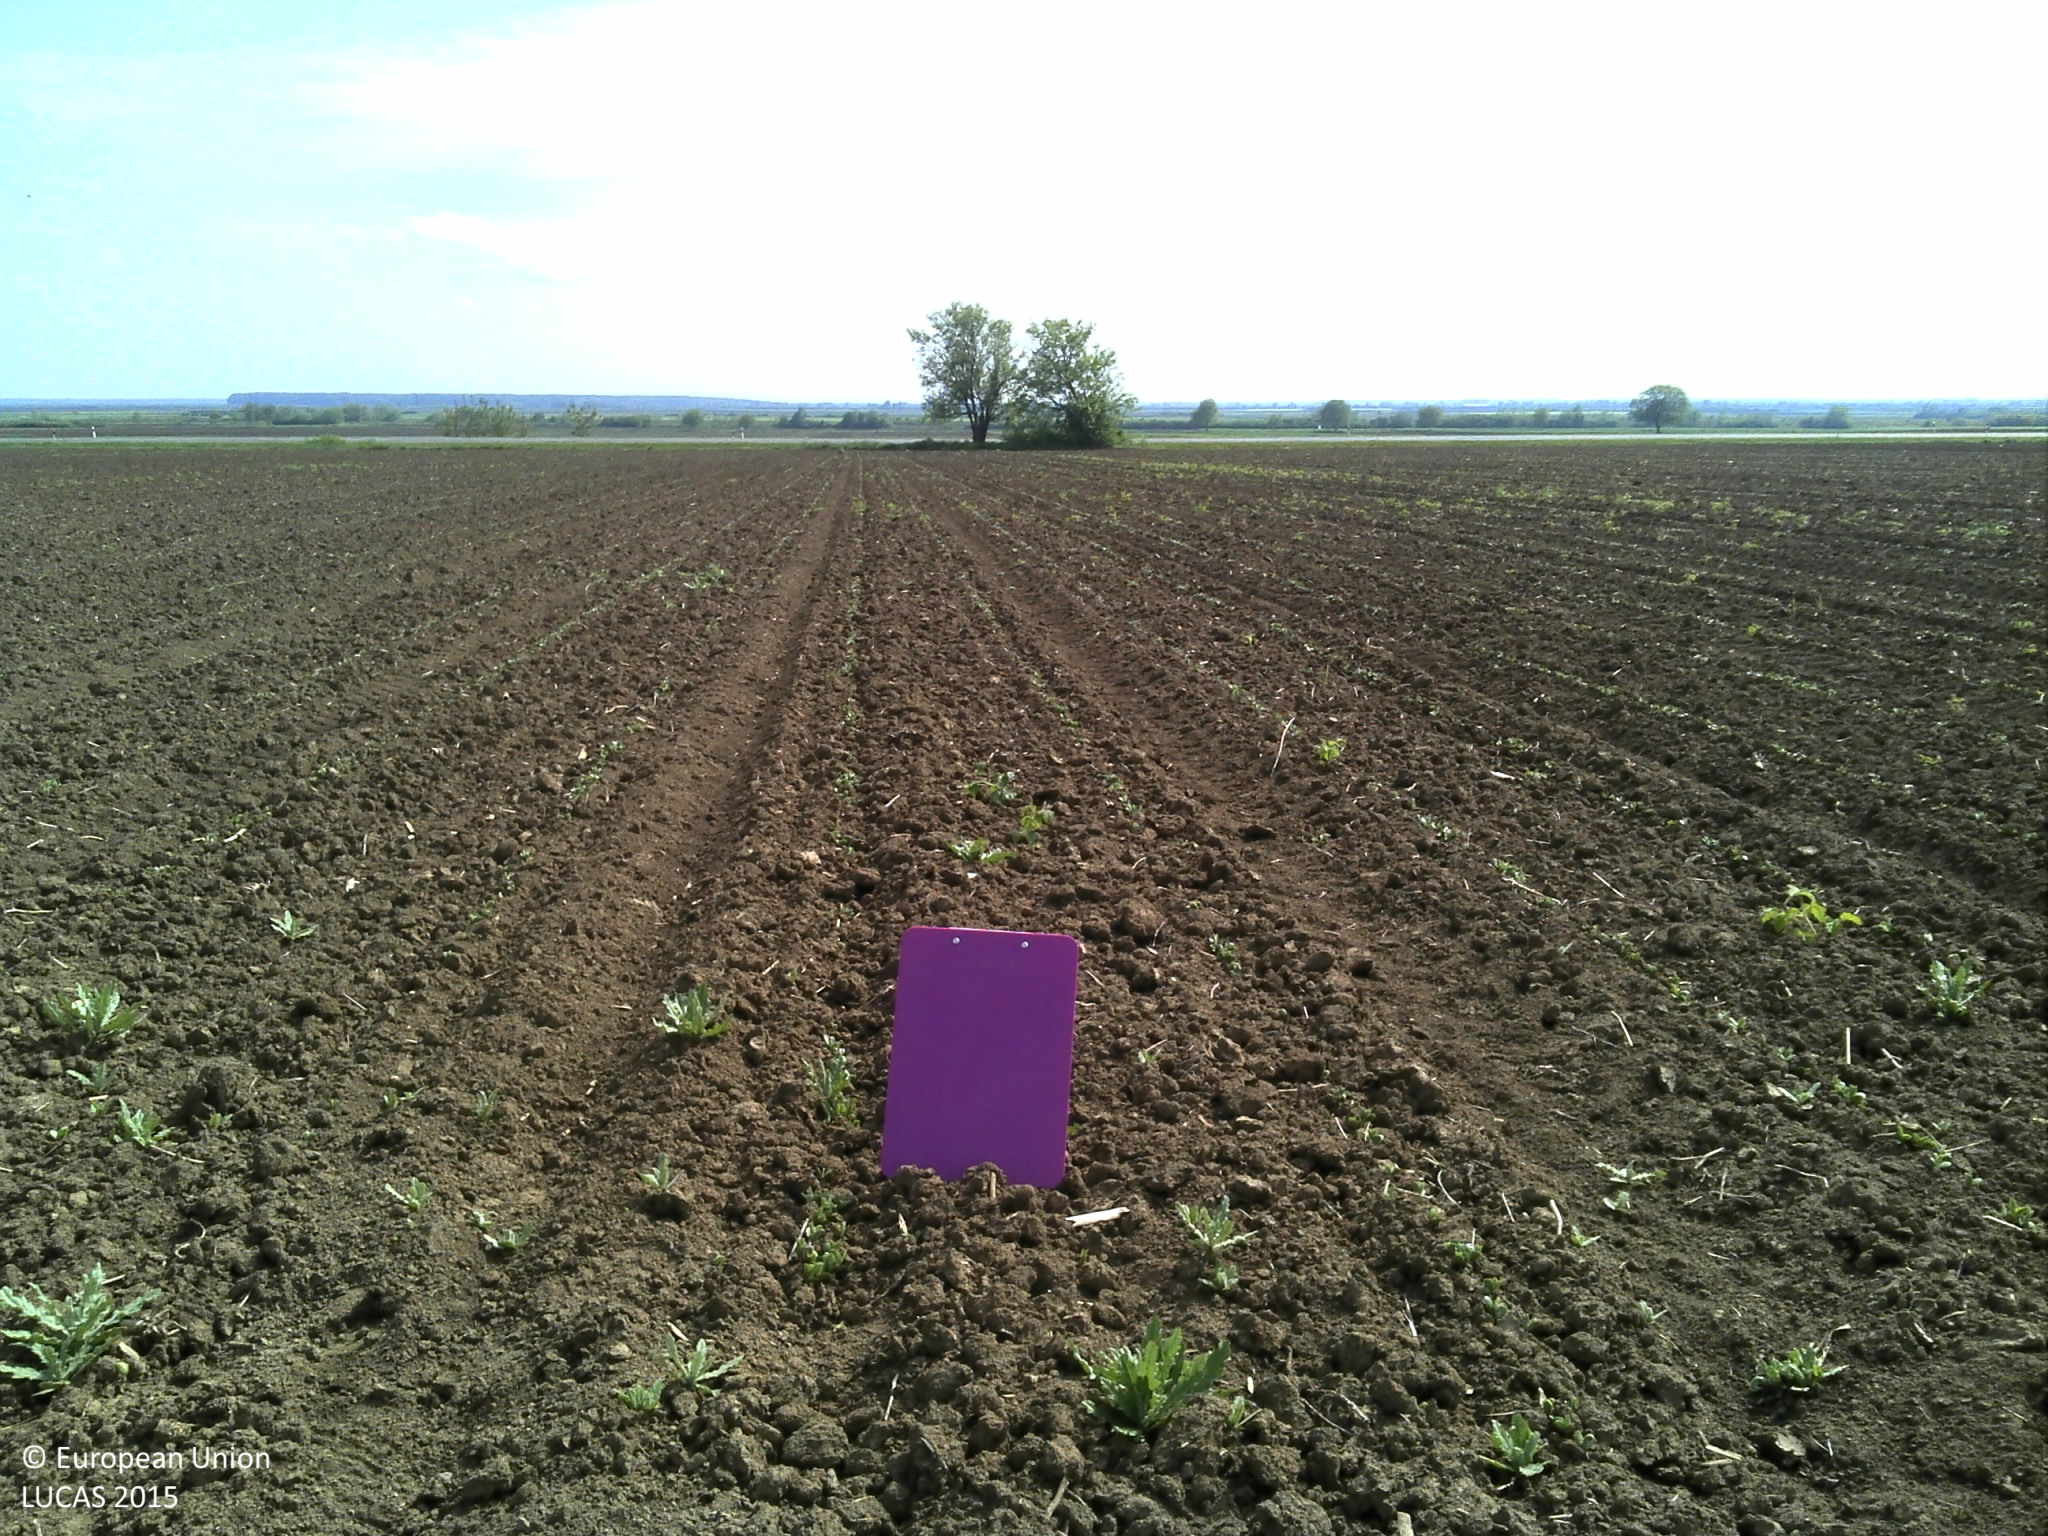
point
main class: Cropland
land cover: Soya
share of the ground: < 10 %
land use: Agriculture (excluding fallow land and kitchen gardens)
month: May
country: HR
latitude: 45.1847
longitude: 19.0827
